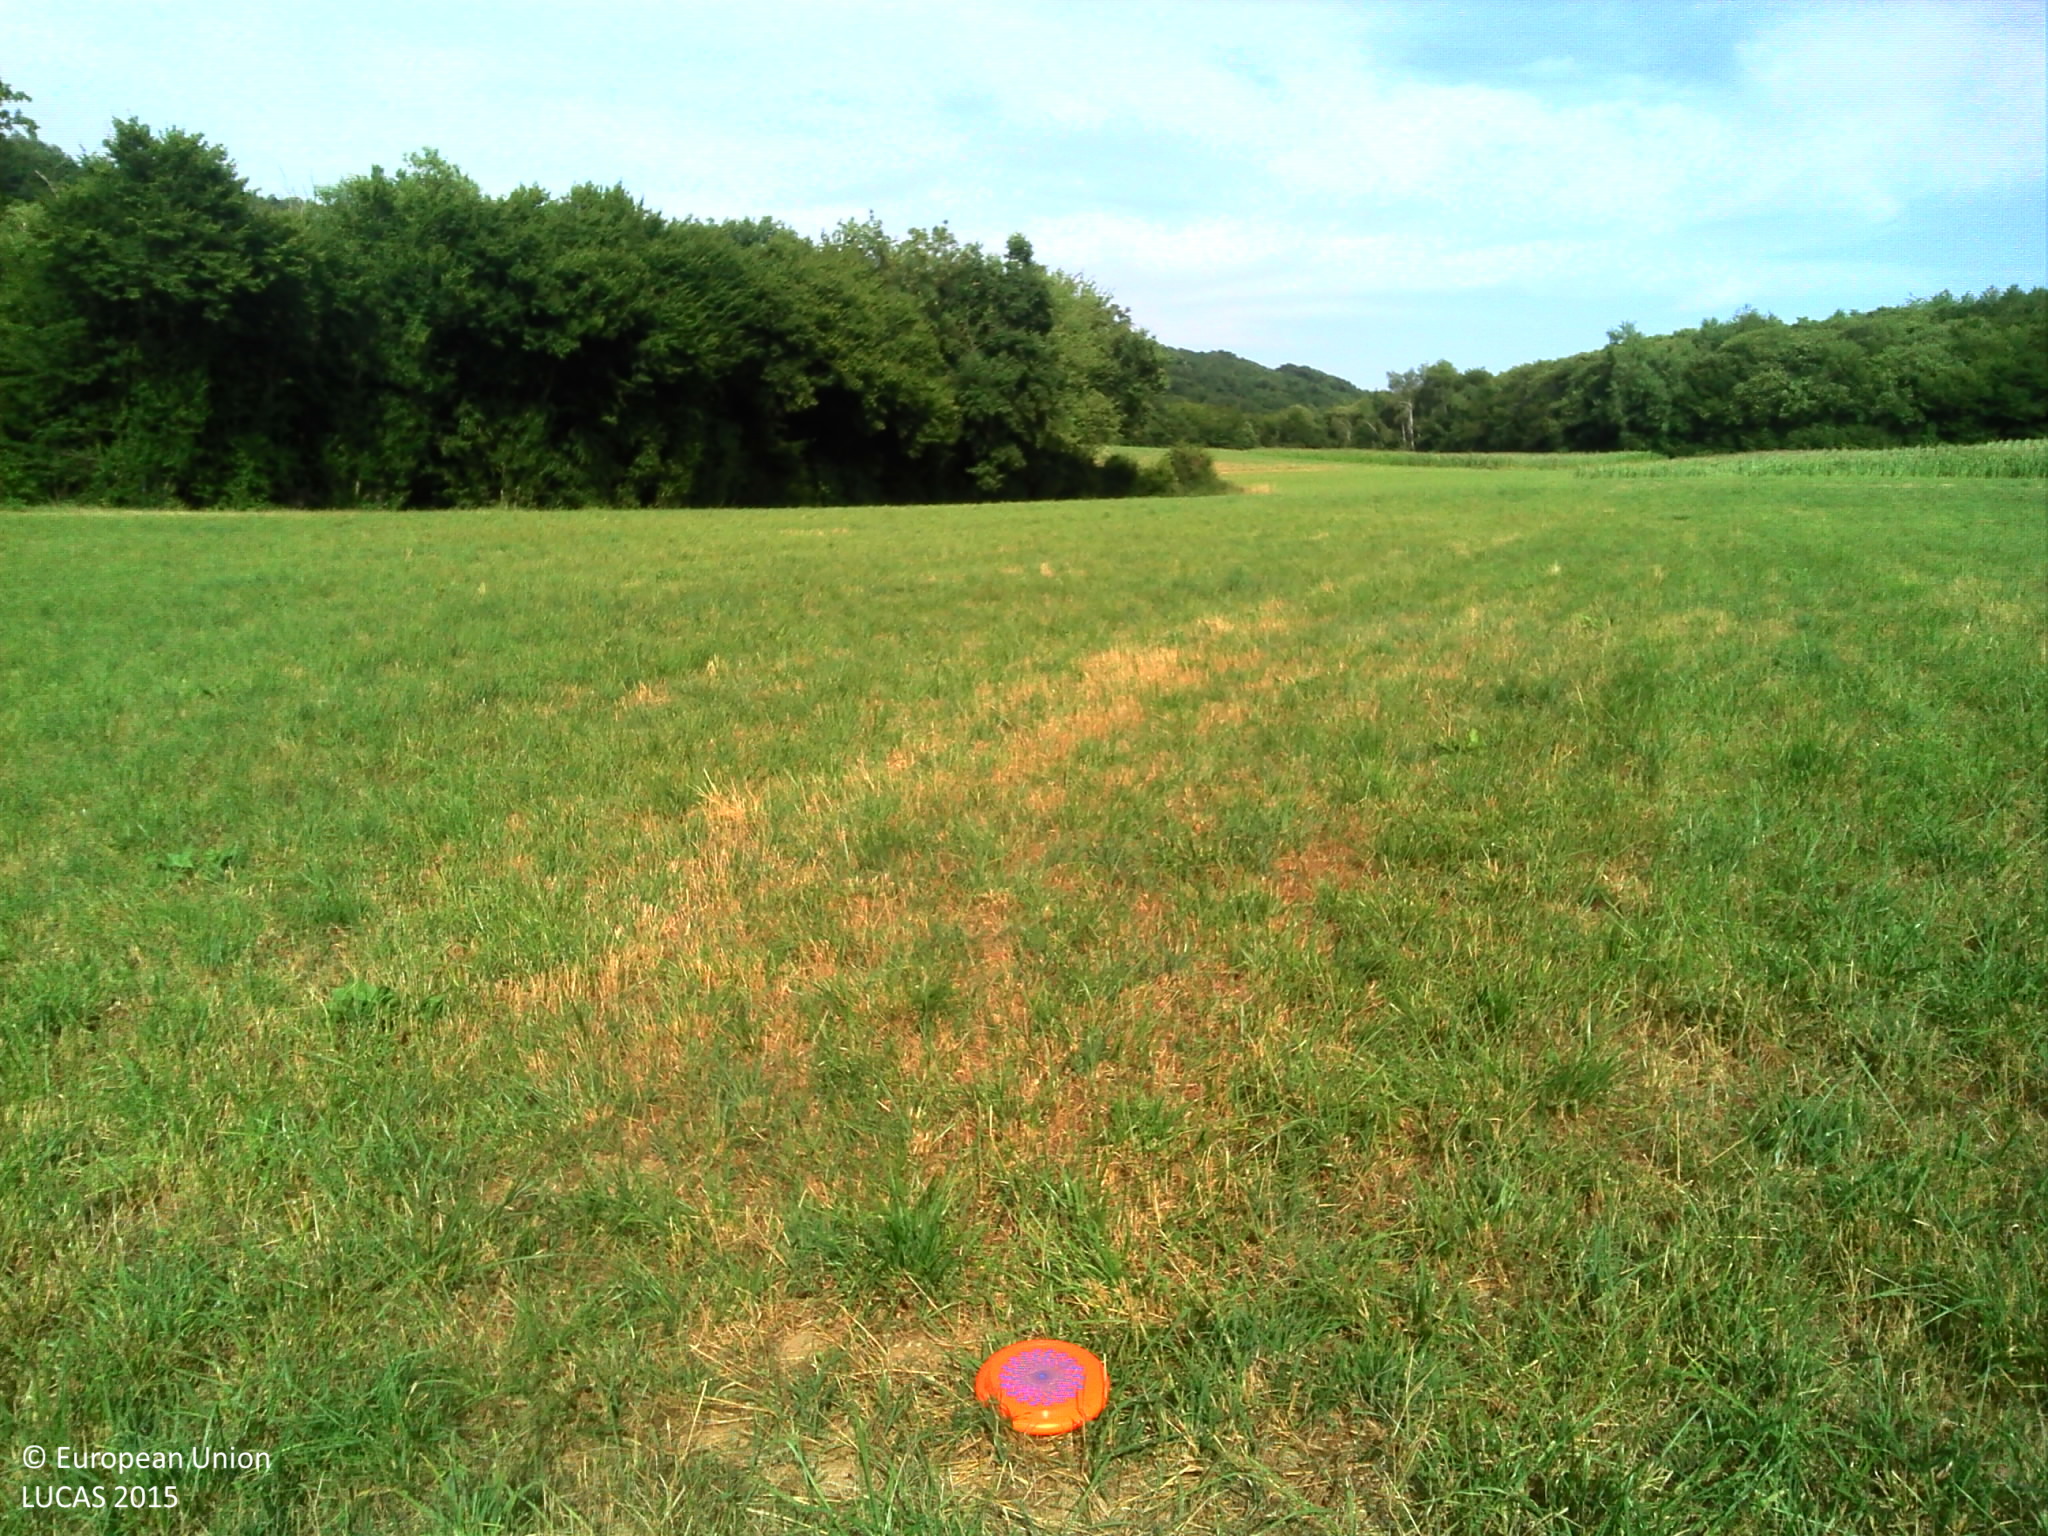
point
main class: Grassland
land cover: Grassland without tree/shrub cover
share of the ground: > 75 %
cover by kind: herbaceous plants 100 %
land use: Agriculture (excluding fallow land and kitchen gardens)
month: July
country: FR
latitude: 45.6028
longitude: 5.4016
